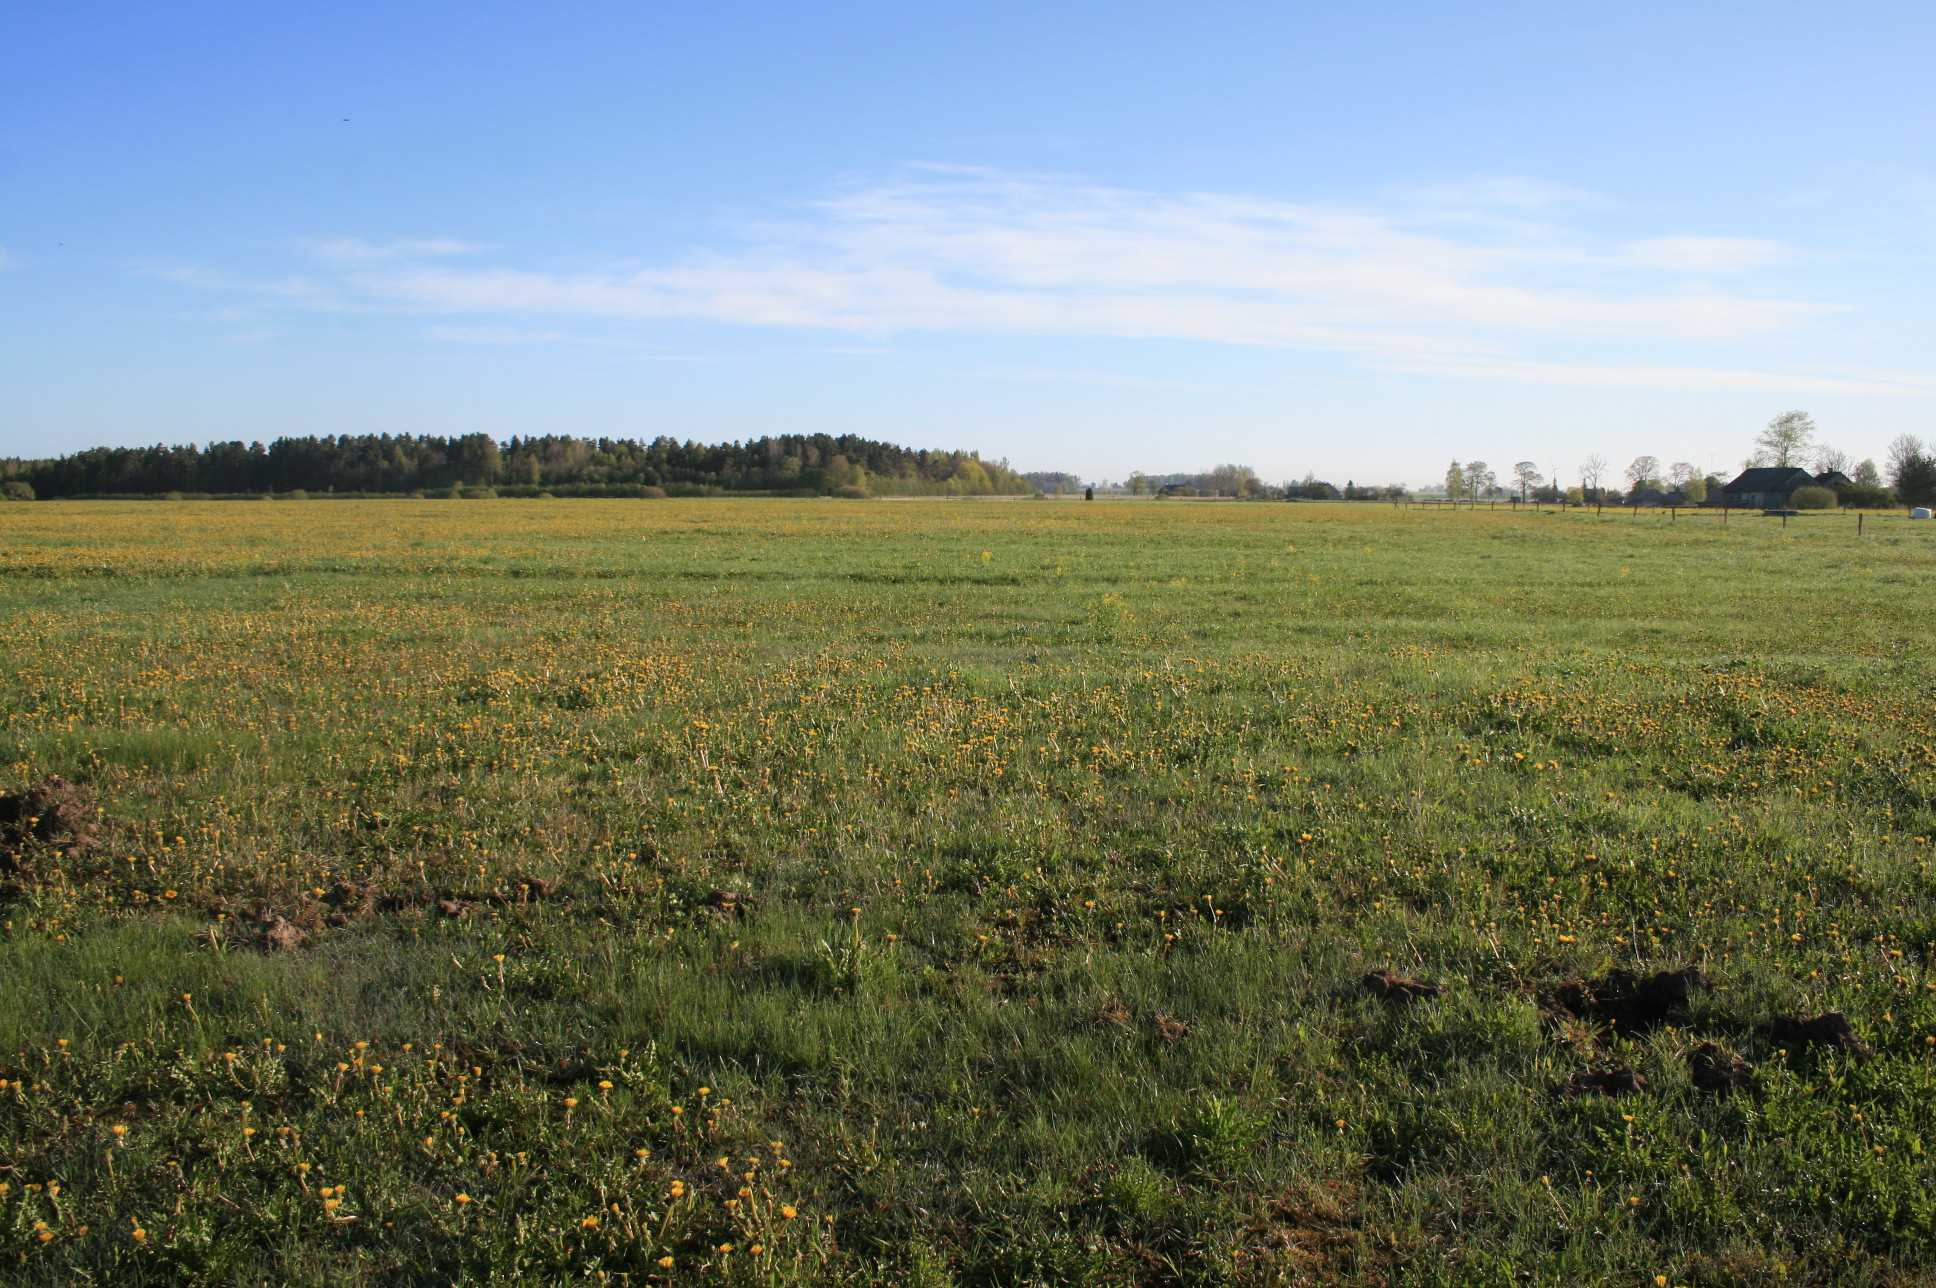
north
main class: Grassland
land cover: Grassland without tree/shrub cover
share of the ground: > 75 %
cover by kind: herbaceous plants 100 %
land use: Agriculture (excluding fallow land and kitchen gardens)
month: May
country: LT
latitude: 56.1399
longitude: 21.5181
